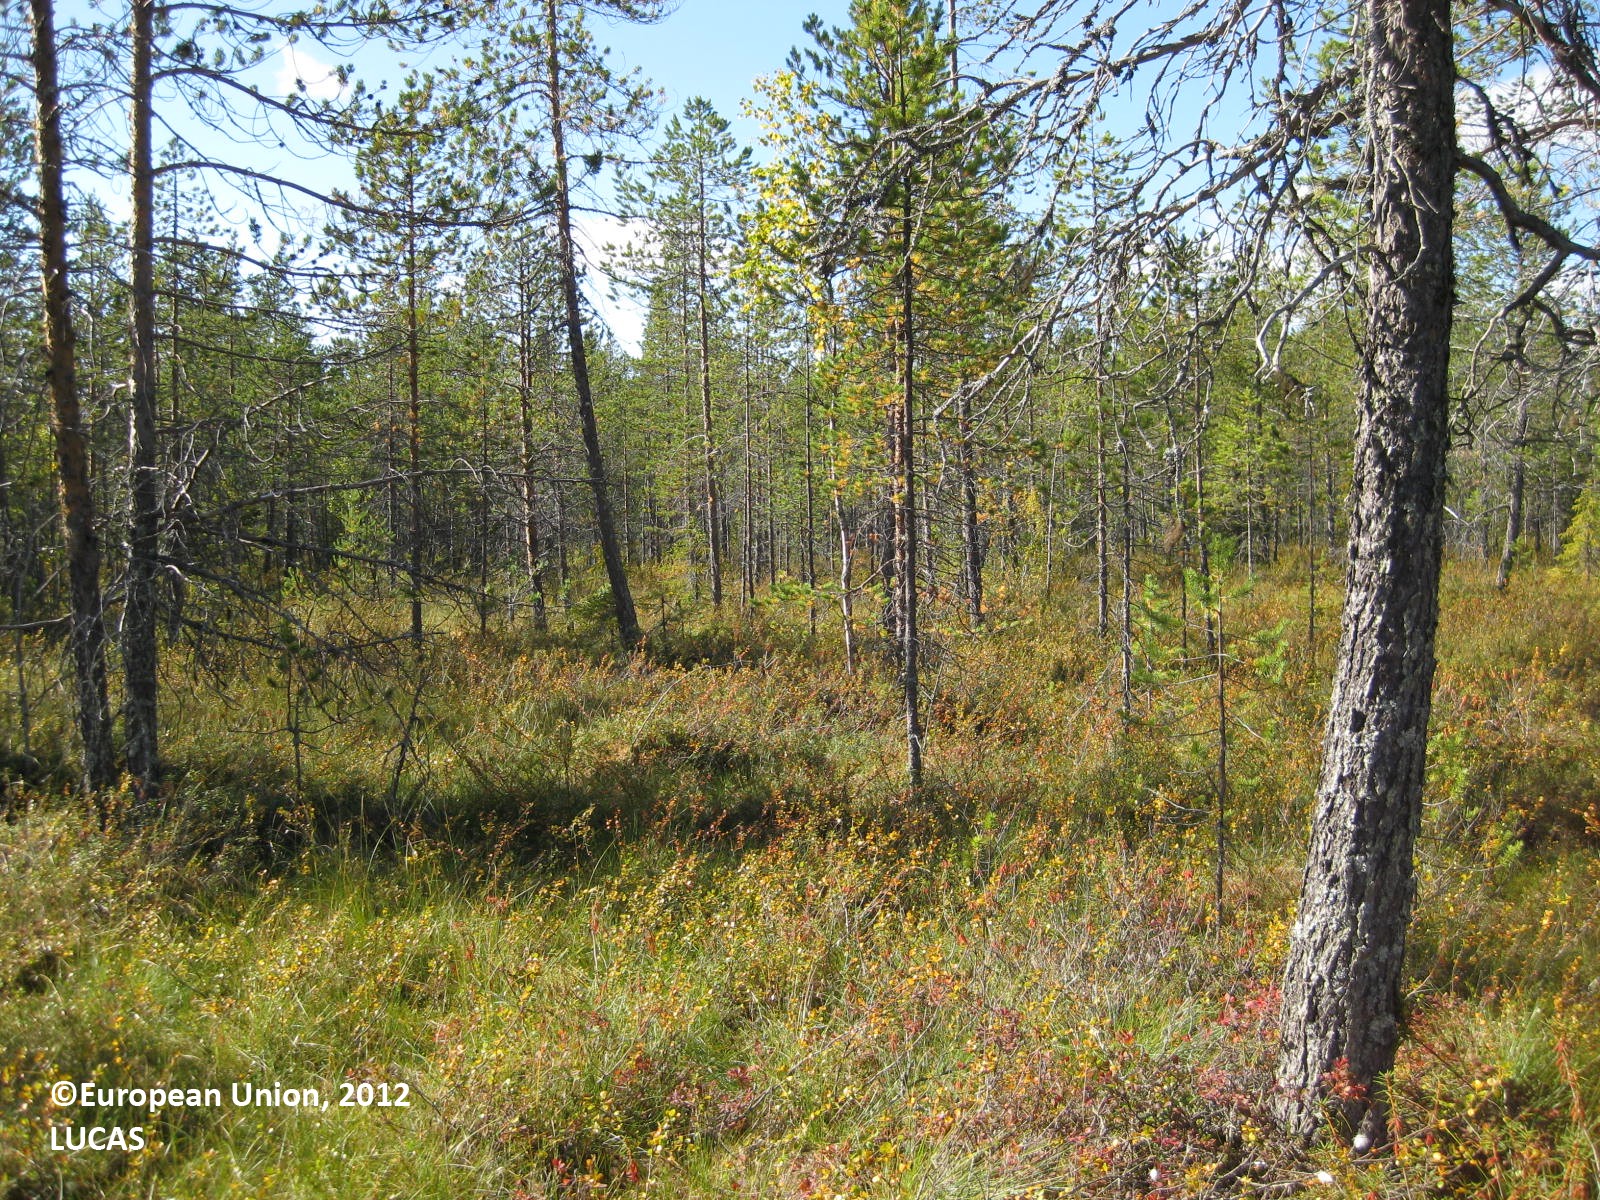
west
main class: Woodland
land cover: Pine dominated coniferous woodland
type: boreal forest
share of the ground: 50 - 75 %
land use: Forestry
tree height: > 5 m
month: August
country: FI
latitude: 66.0642
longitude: 29.6097
